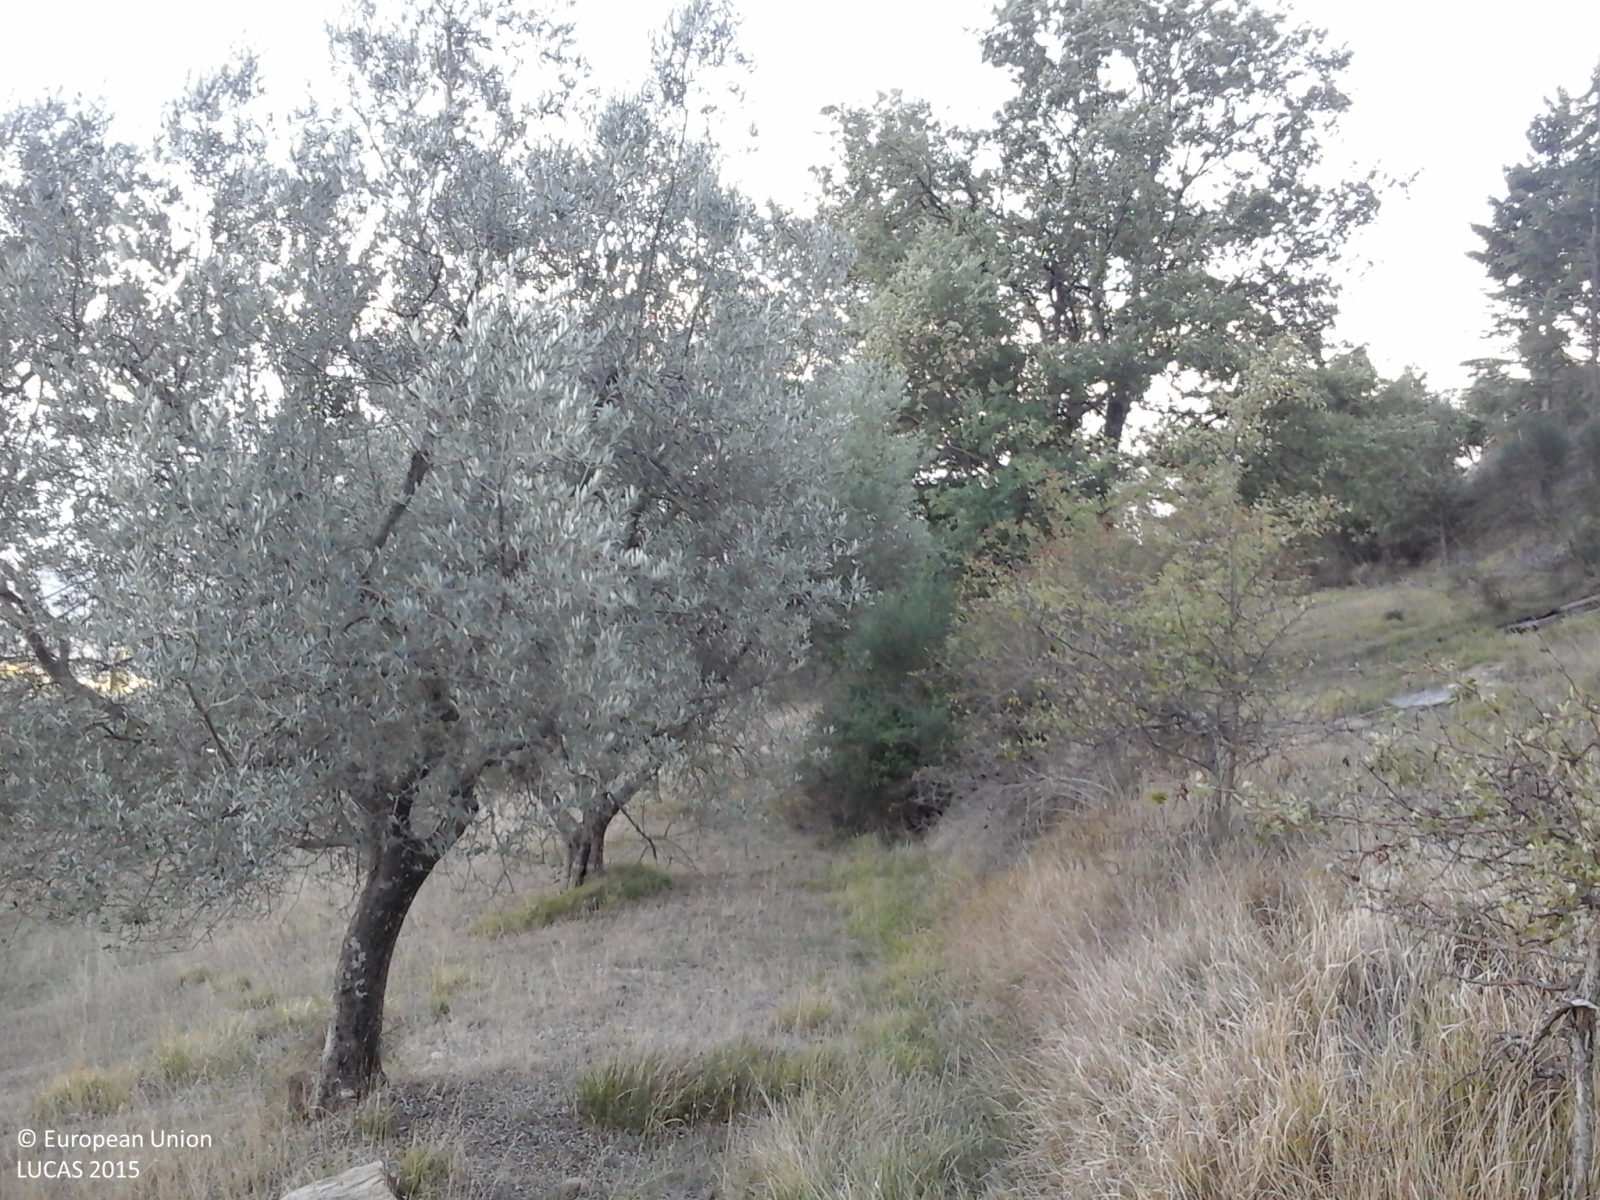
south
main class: Cropland
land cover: Olive groves
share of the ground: 25 - 50 %
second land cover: Spontaneously vegetated surfaces
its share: 50 - 75 %
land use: Agriculture (excluding fallow land and kitchen gardens)
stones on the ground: 10 - 25 %
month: September
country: IT
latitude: 43.1885
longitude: 12.2698
